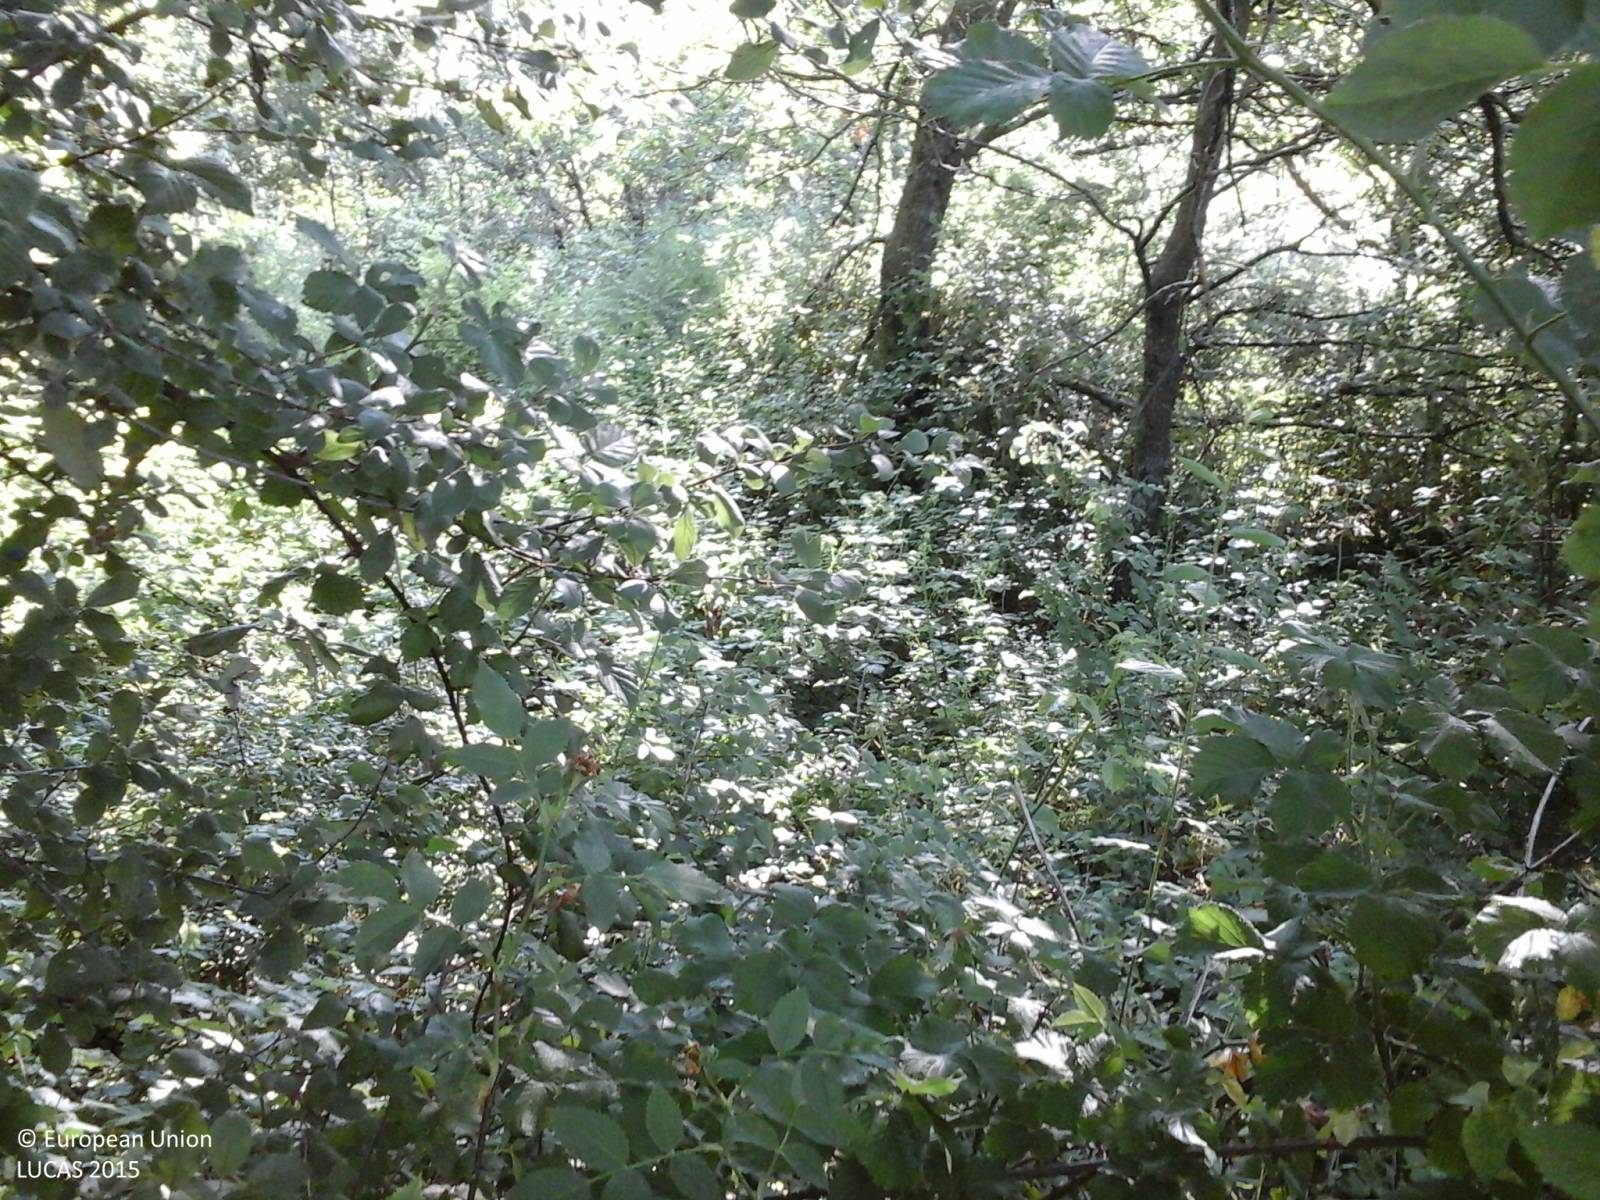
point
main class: Woodland
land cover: Broadleaved woodland
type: thermophilous deciduous forest
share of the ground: > 75 %
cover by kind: broadleaved forest trees 90 %, shrubs 10 %
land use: Forestry
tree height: > 5 m
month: June
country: IT
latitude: 42.6151
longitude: 12.0535
